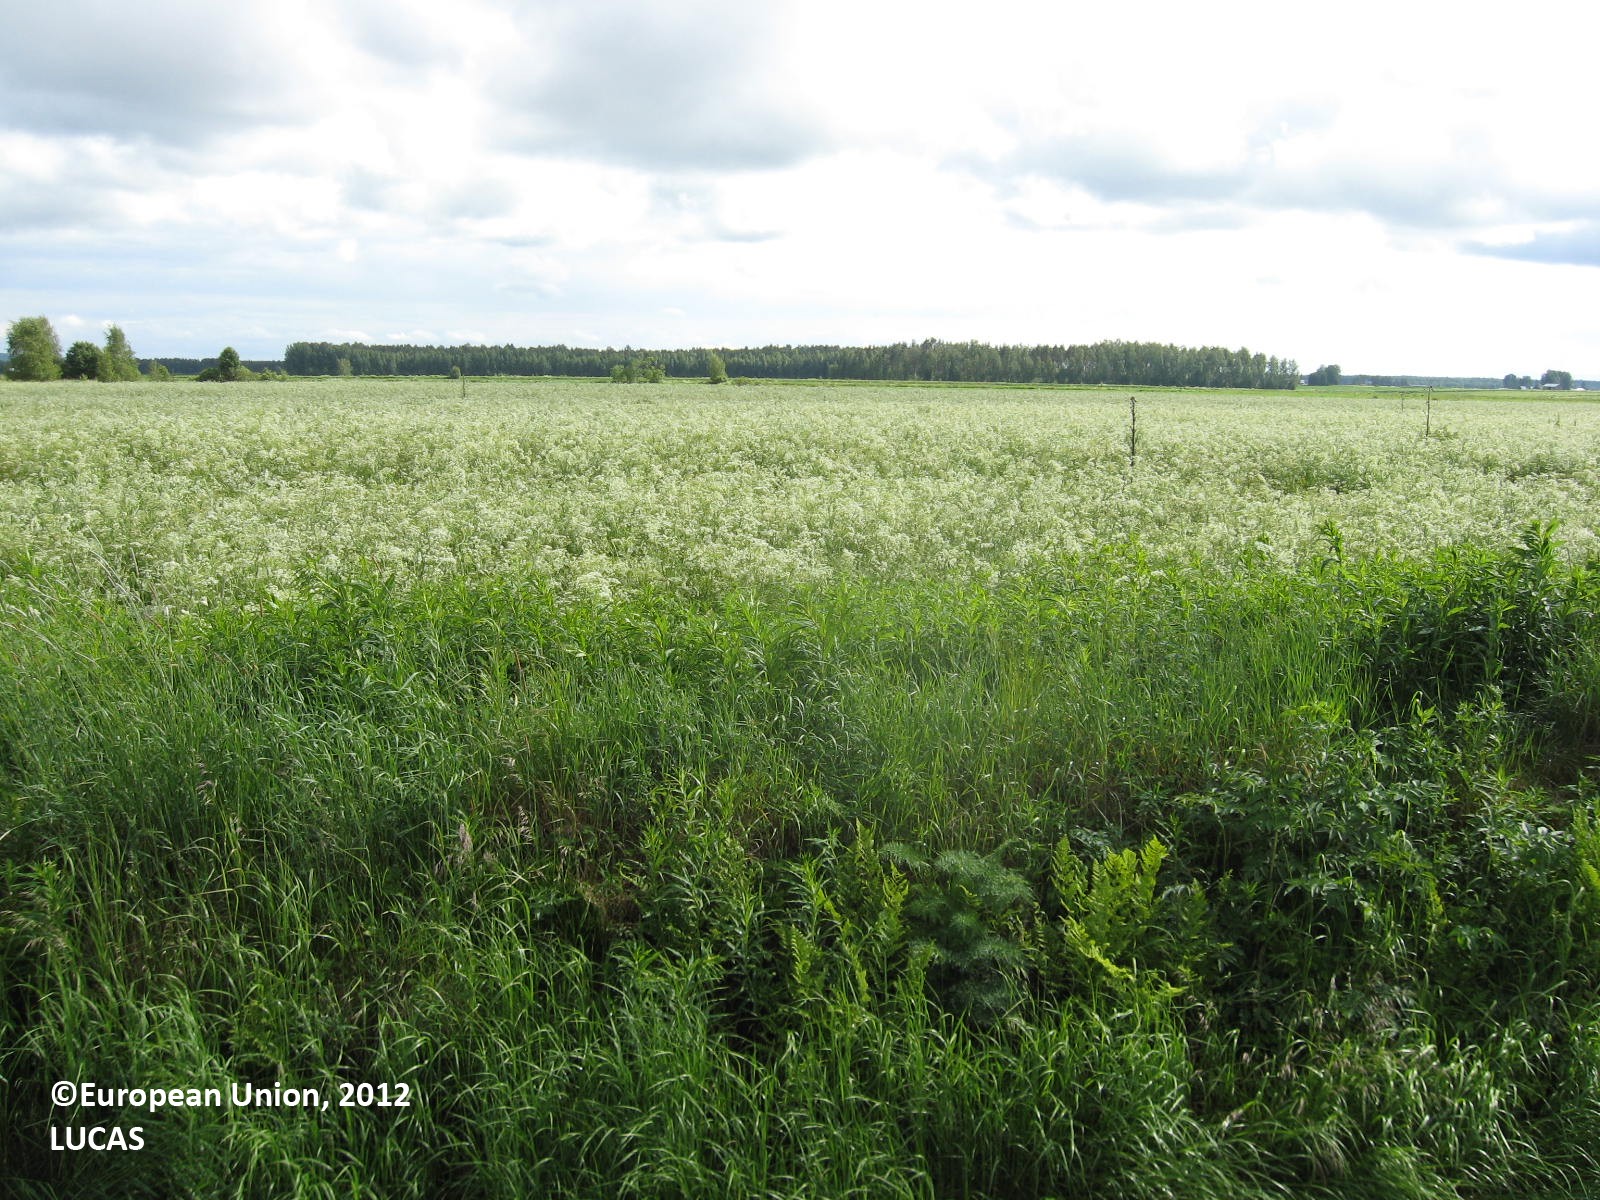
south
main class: Cropland
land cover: Oats
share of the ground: > 75 %
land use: Agriculture (excluding fallow land and kitchen gardens)
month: June
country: FI
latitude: 63.0271
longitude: 22.8822
